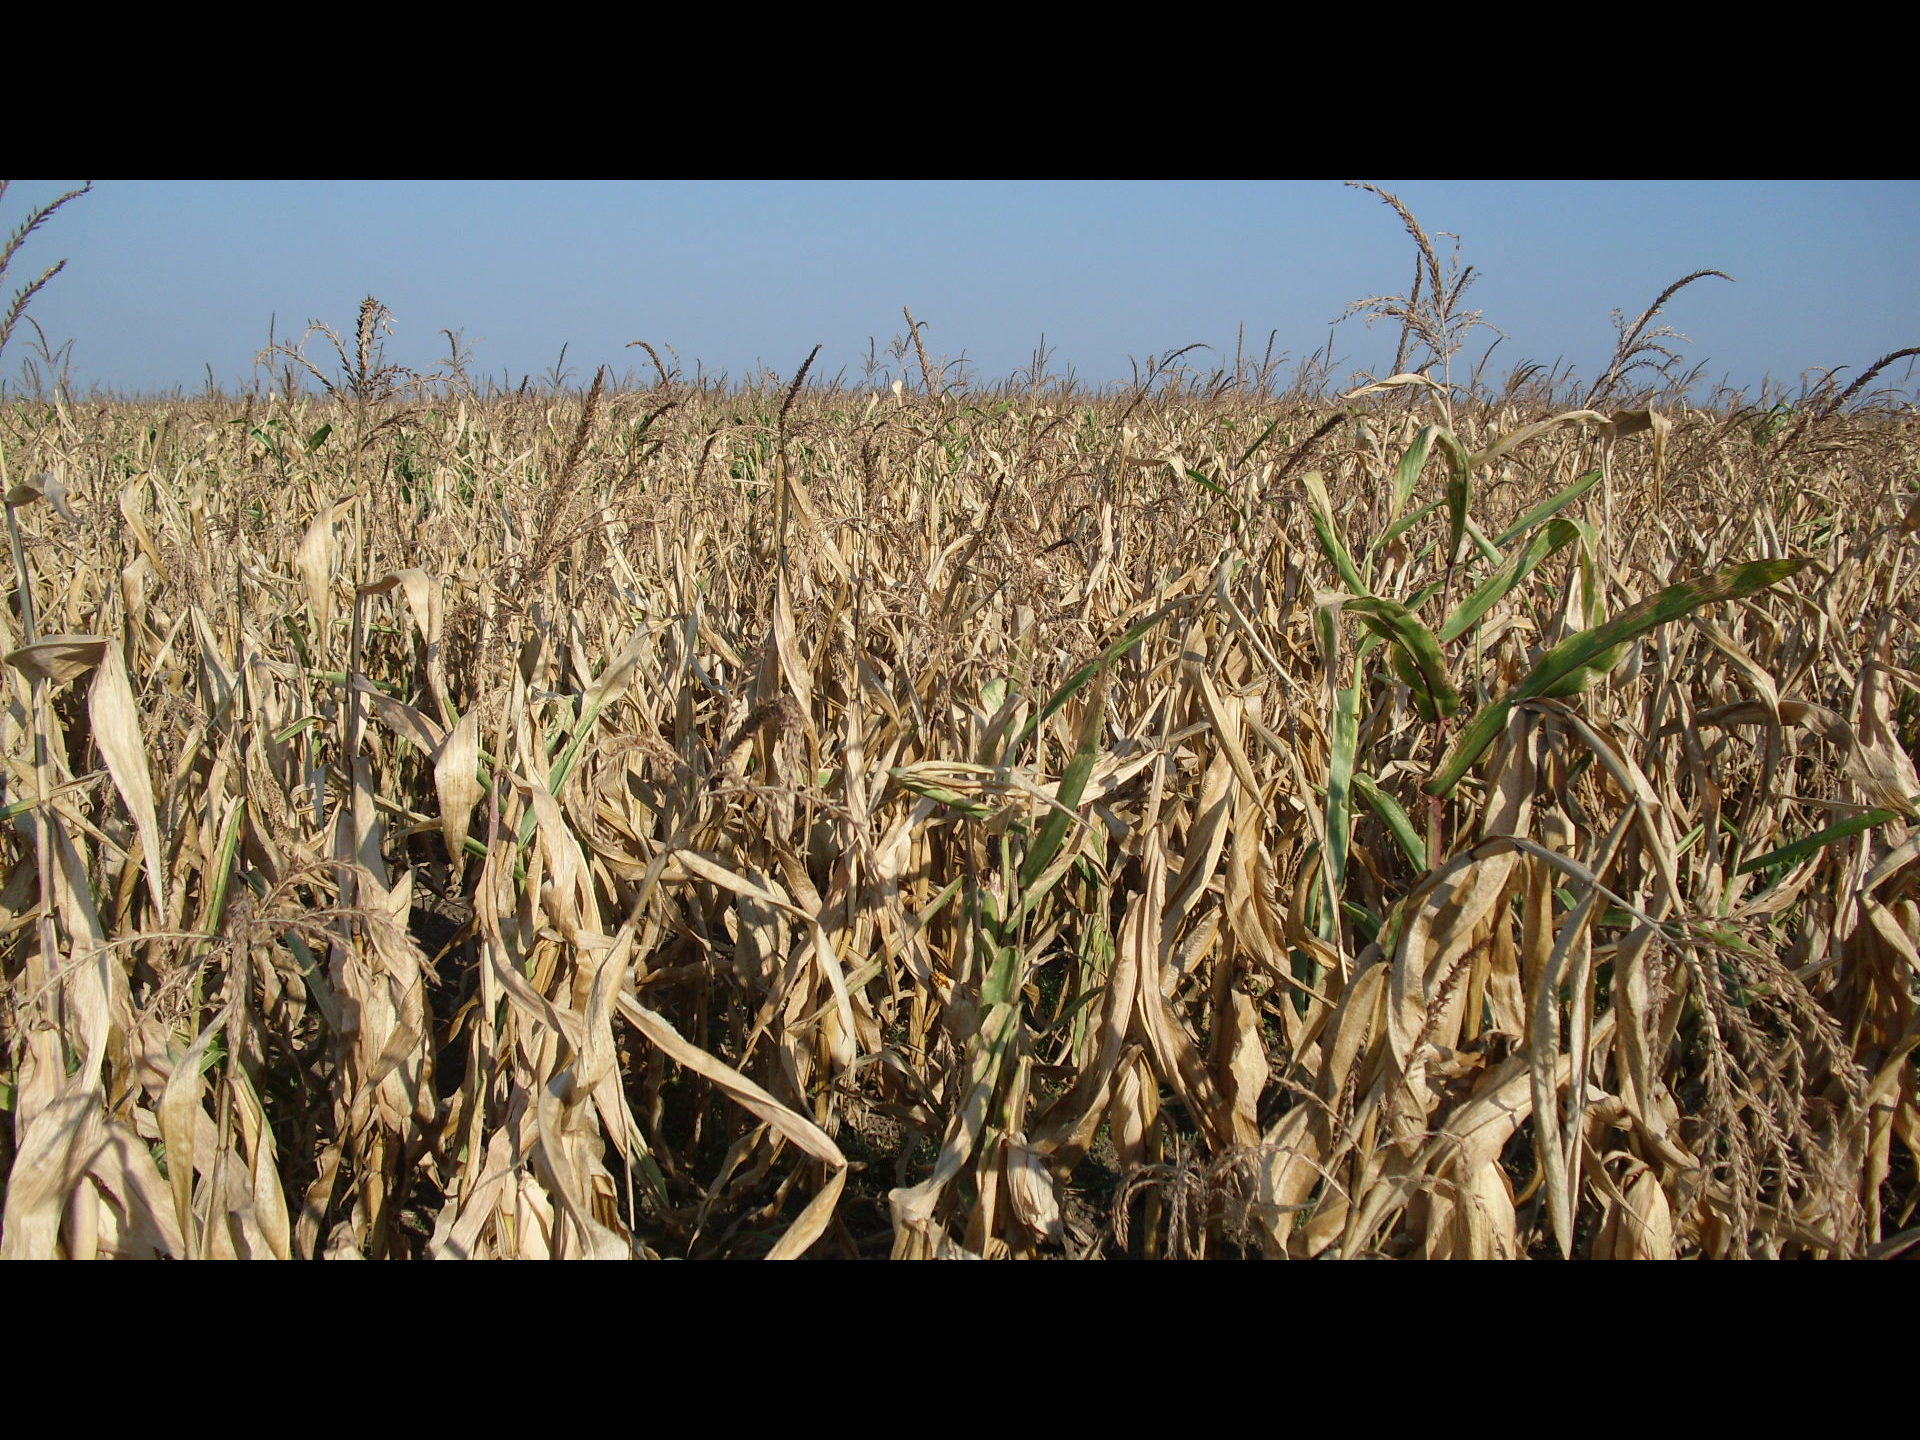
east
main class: Cropland
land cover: Maize
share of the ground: > 75 %
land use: Agriculture (excluding fallow land and kitchen gardens)
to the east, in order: Maize
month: September
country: BG
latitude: 43.9669
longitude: 22.5613
